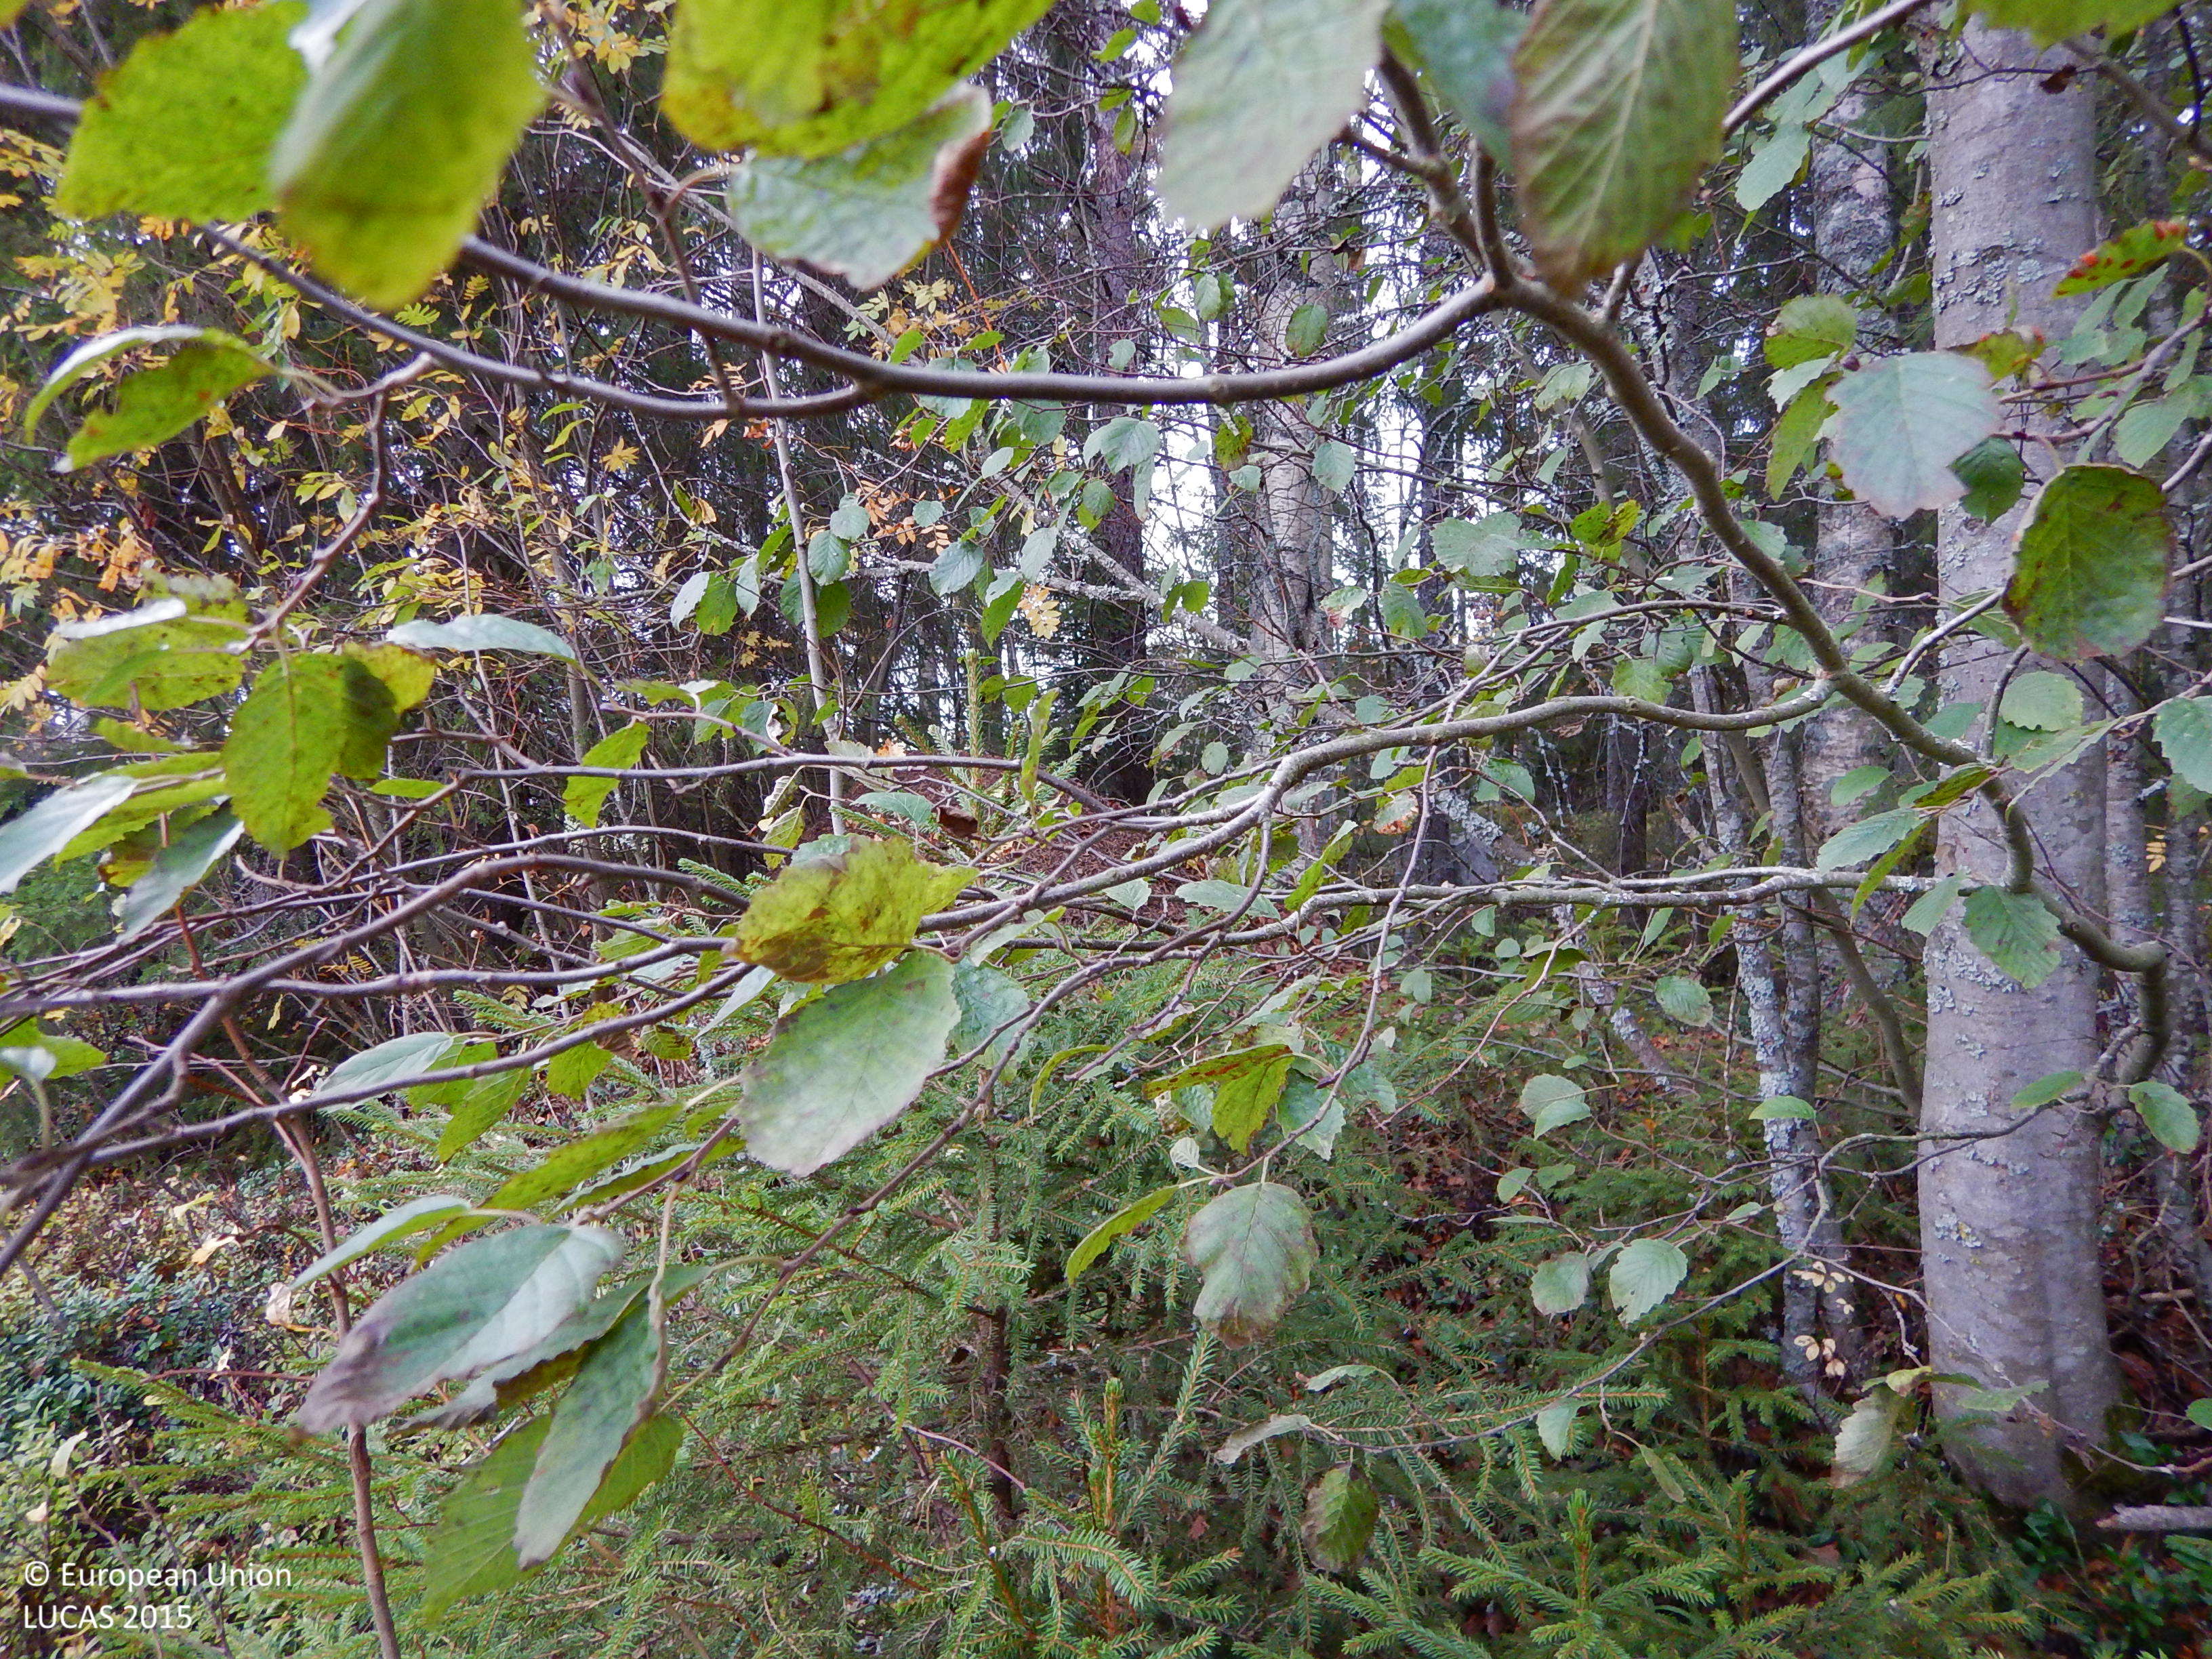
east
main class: Woodland
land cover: Spruce dominated mixed woodland
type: boreal forest
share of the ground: > 75 %
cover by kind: coniferous forest trees 60 %, broadleaved forest trees 20 %, shrubs 10 %, herbaceous plants 5 %, lichens and mosses 5 %
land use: Forestry
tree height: > 5 m
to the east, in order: Spruce dominated mixed woodland; Ditches and canals; Tracks; Grassland without tree/shrub cover; Ditches and canals; Pine dominated coniferous woodland; Ditches and canals; Grassland without tree/shrub cover
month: October
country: SE
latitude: 64.8811
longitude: 20.8915
